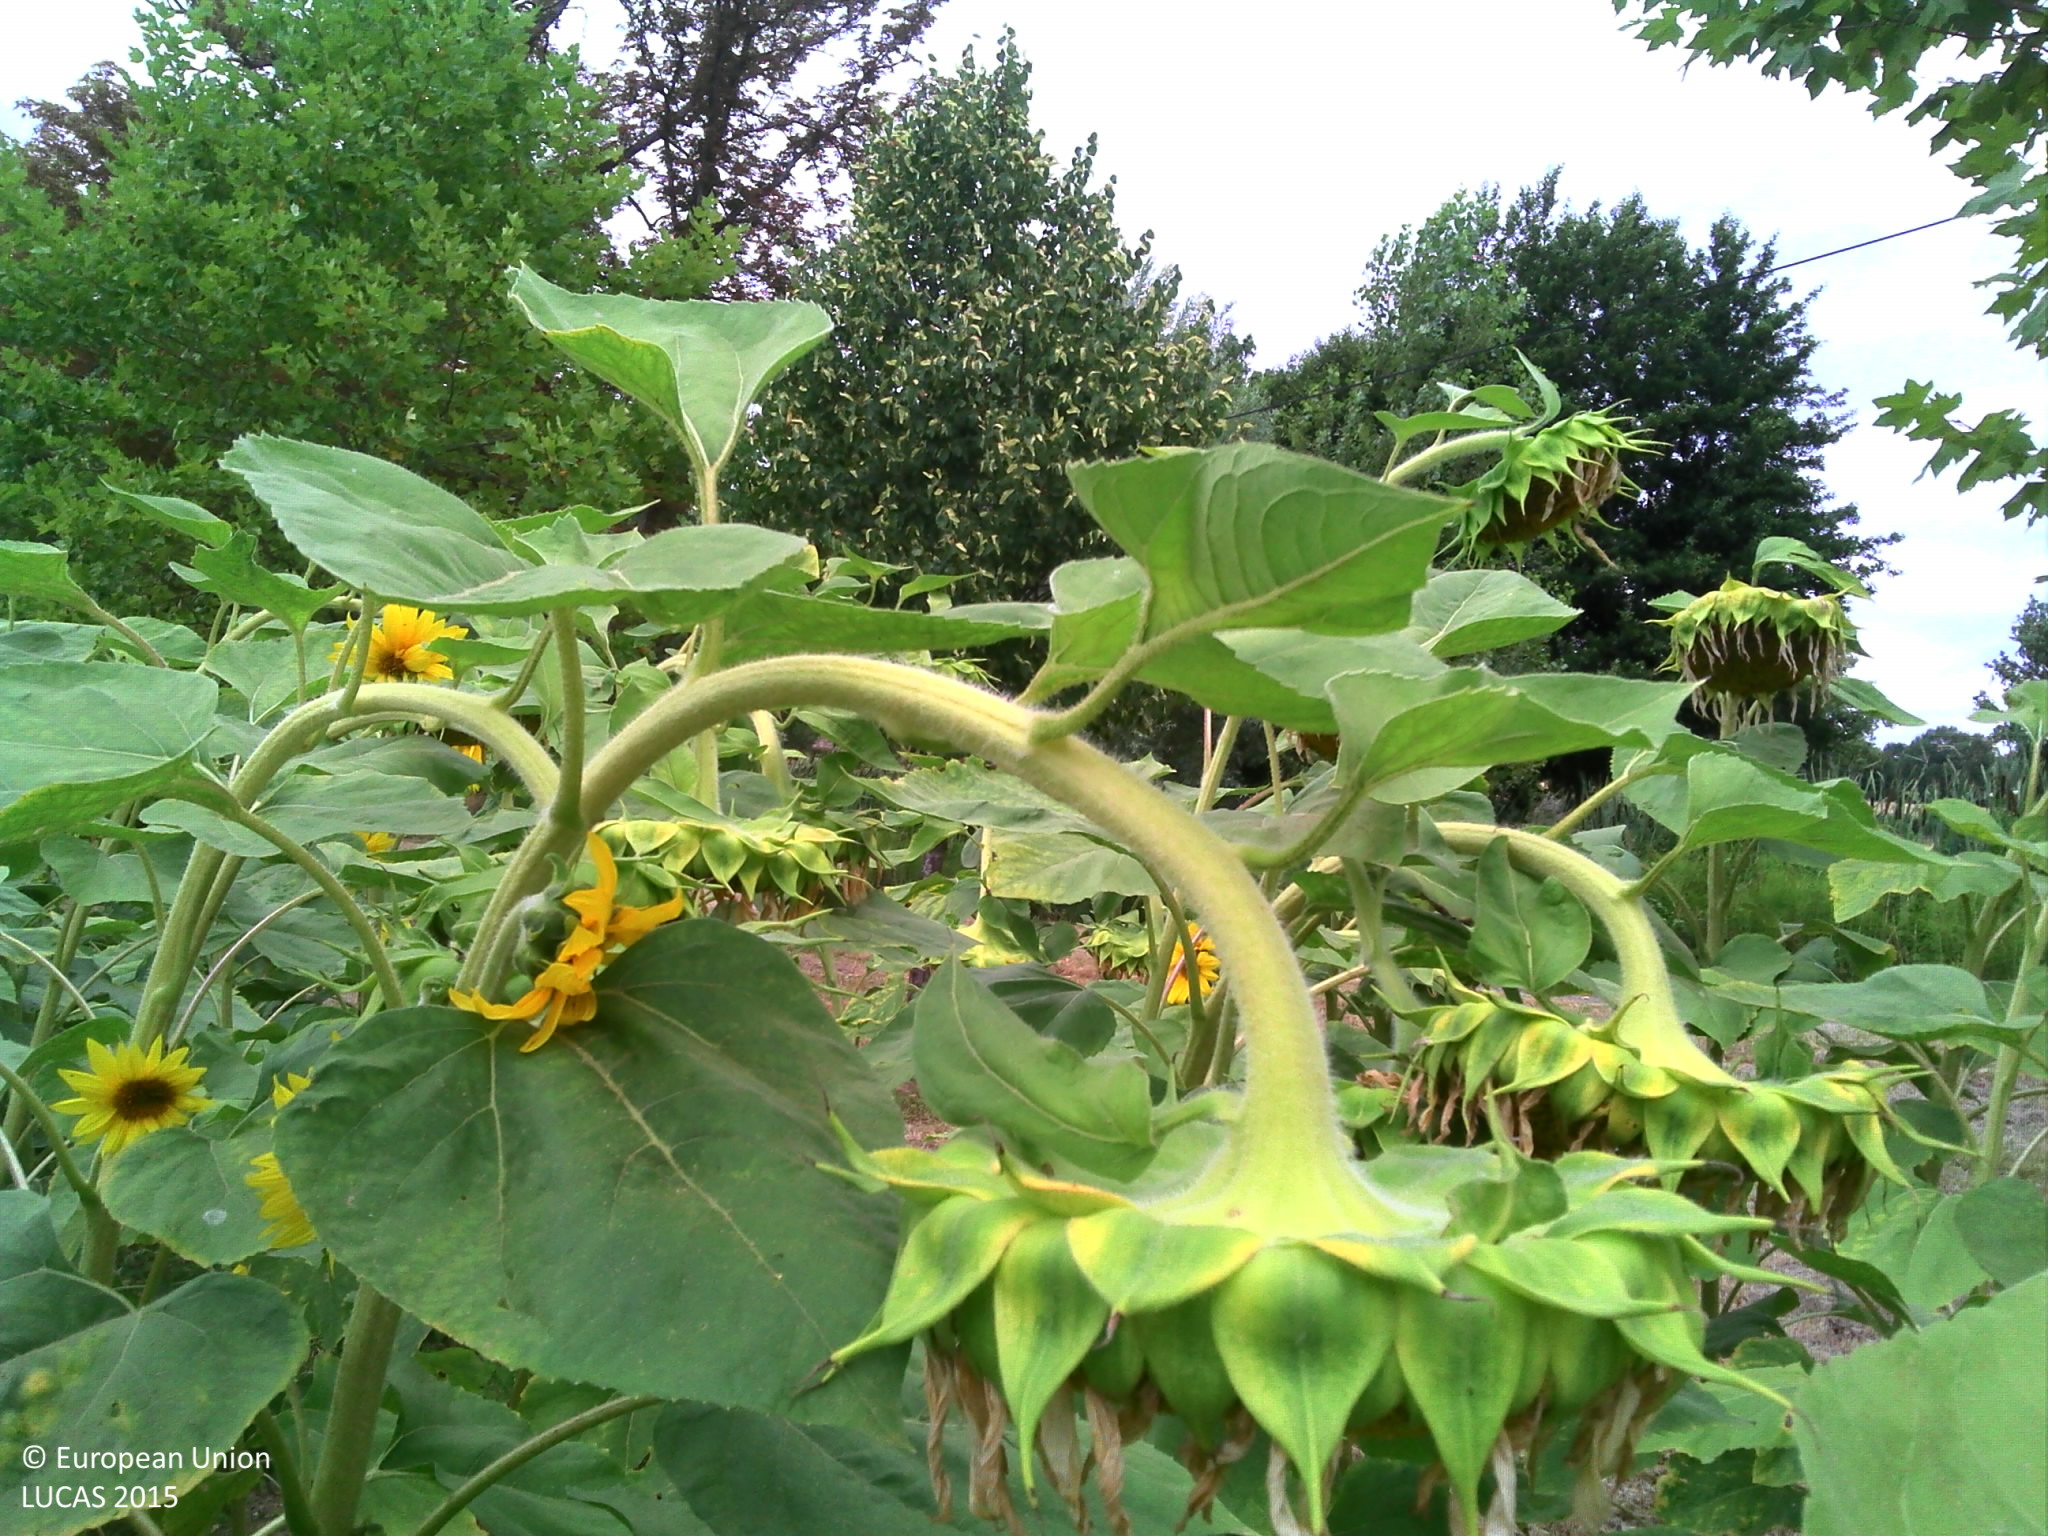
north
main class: Cropland
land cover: Sunflower
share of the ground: > 75 %
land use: Agriculture (excluding fallow land and kitchen gardens)
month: July
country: FR
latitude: 44.3023
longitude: 0.5803
